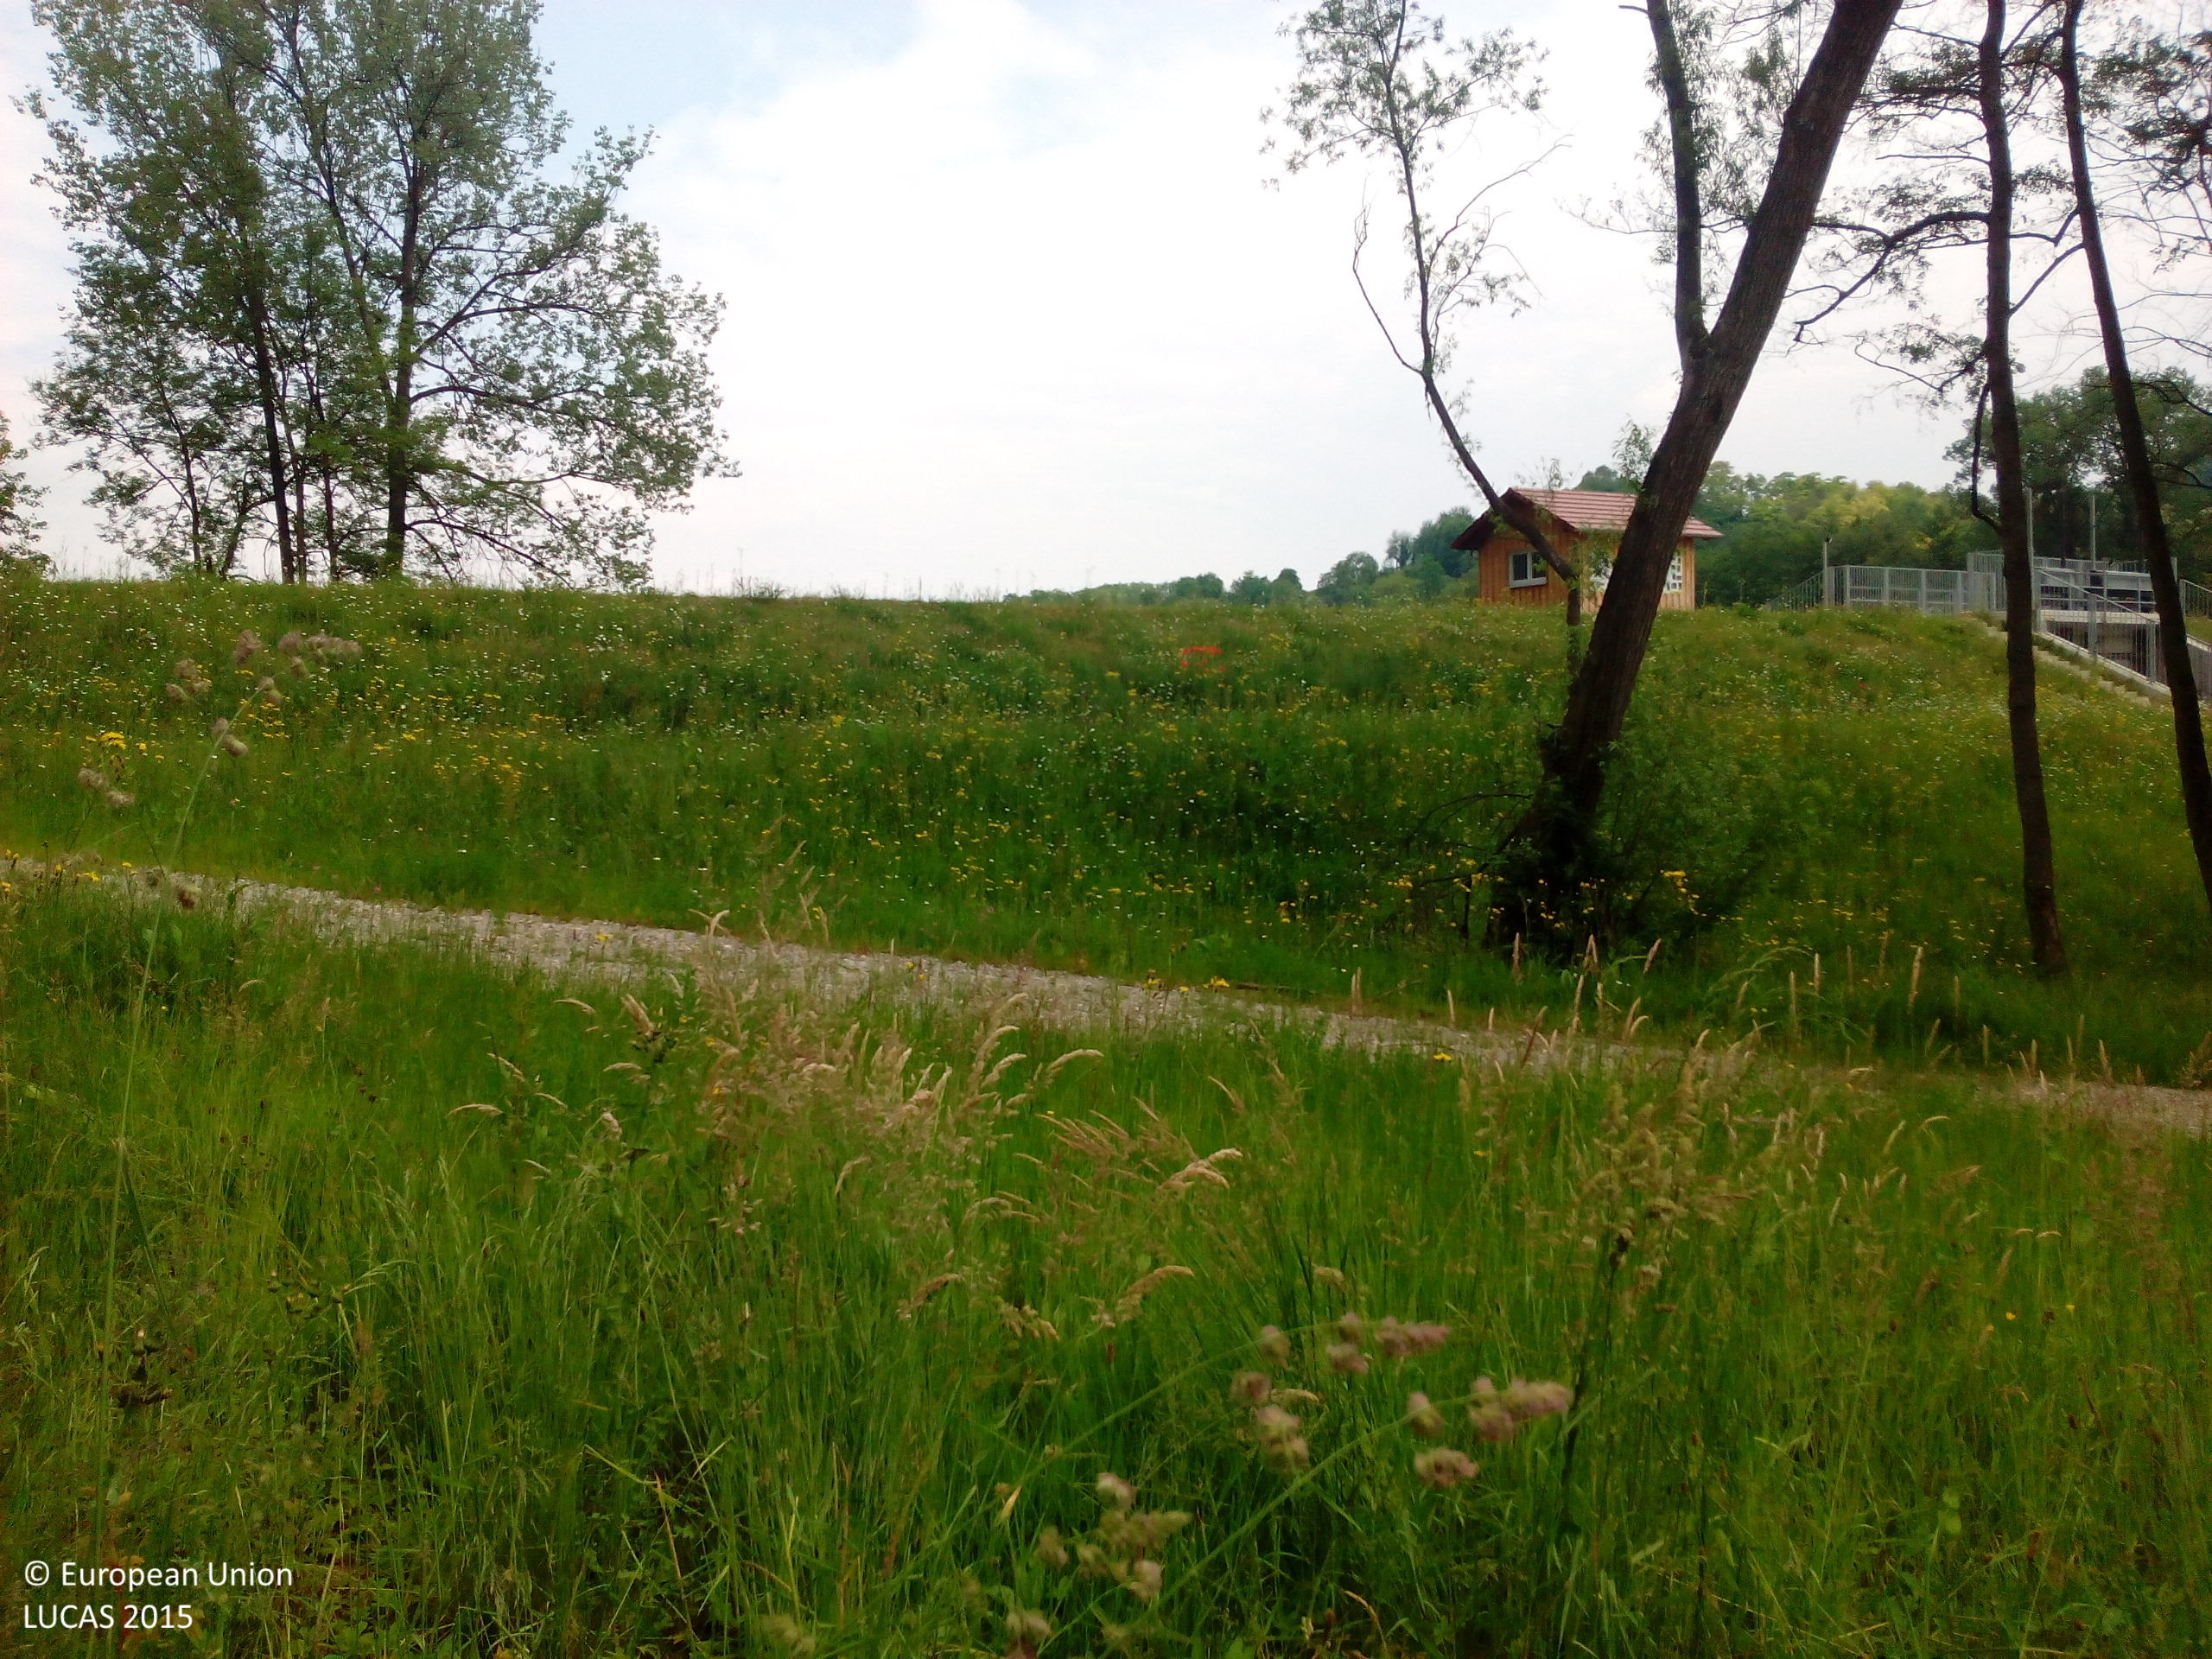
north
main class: Grassland
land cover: Grassland with sparse tree/shrub cover
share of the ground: > 75 %
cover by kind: herbaceous plants 90 %, broadleaved forest trees 5 %, shrubs 5 %
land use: Semi-natural and natural areas not in use
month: May
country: DE
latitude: 47.7470
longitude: 7.5873
